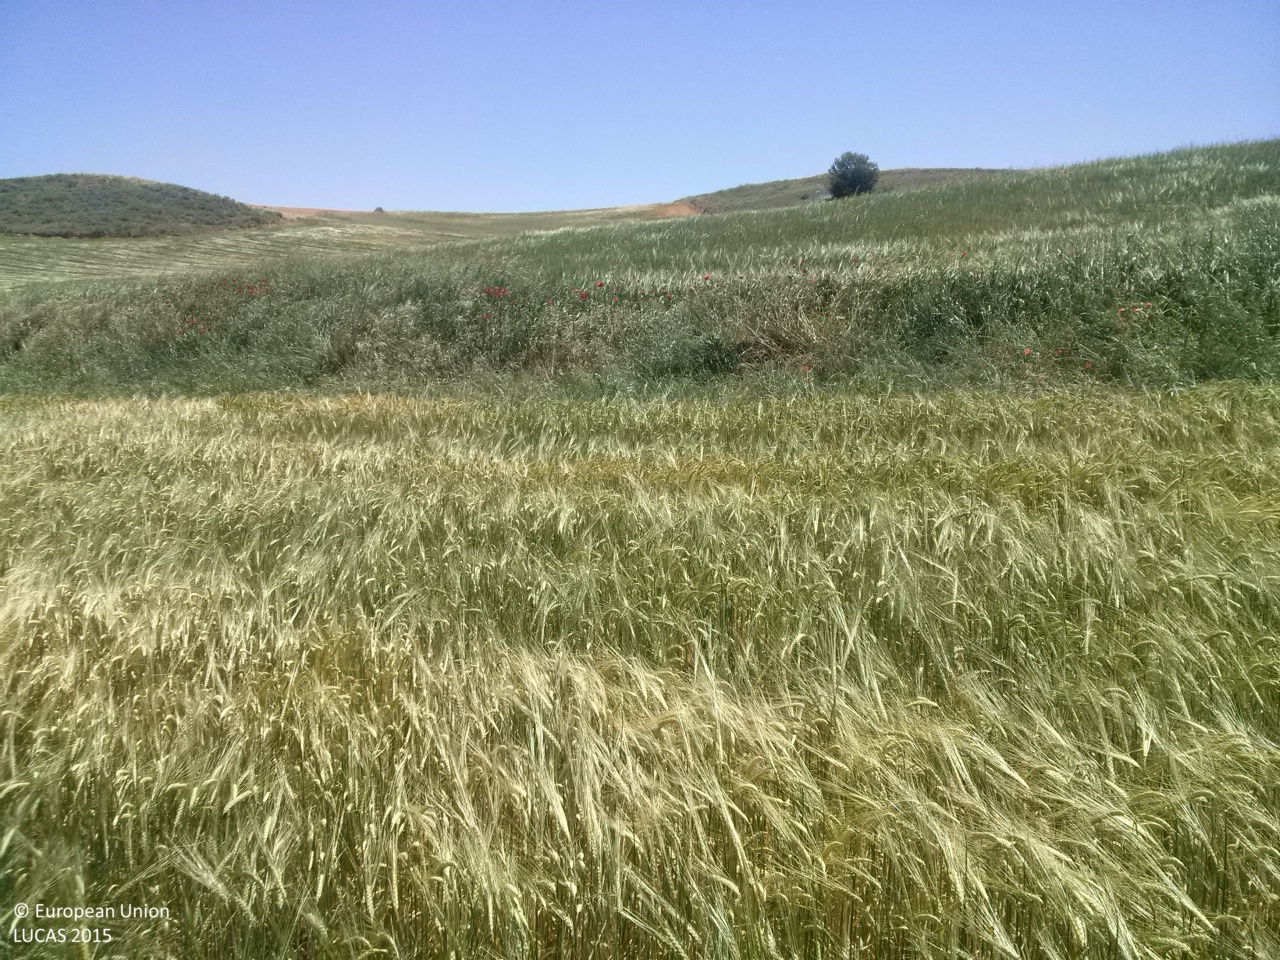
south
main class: Cropland
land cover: Barley
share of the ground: > 75 %
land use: Agriculture (excluding fallow land and kitchen gardens)
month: May
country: ES
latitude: 40.3282
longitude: -2.7481
